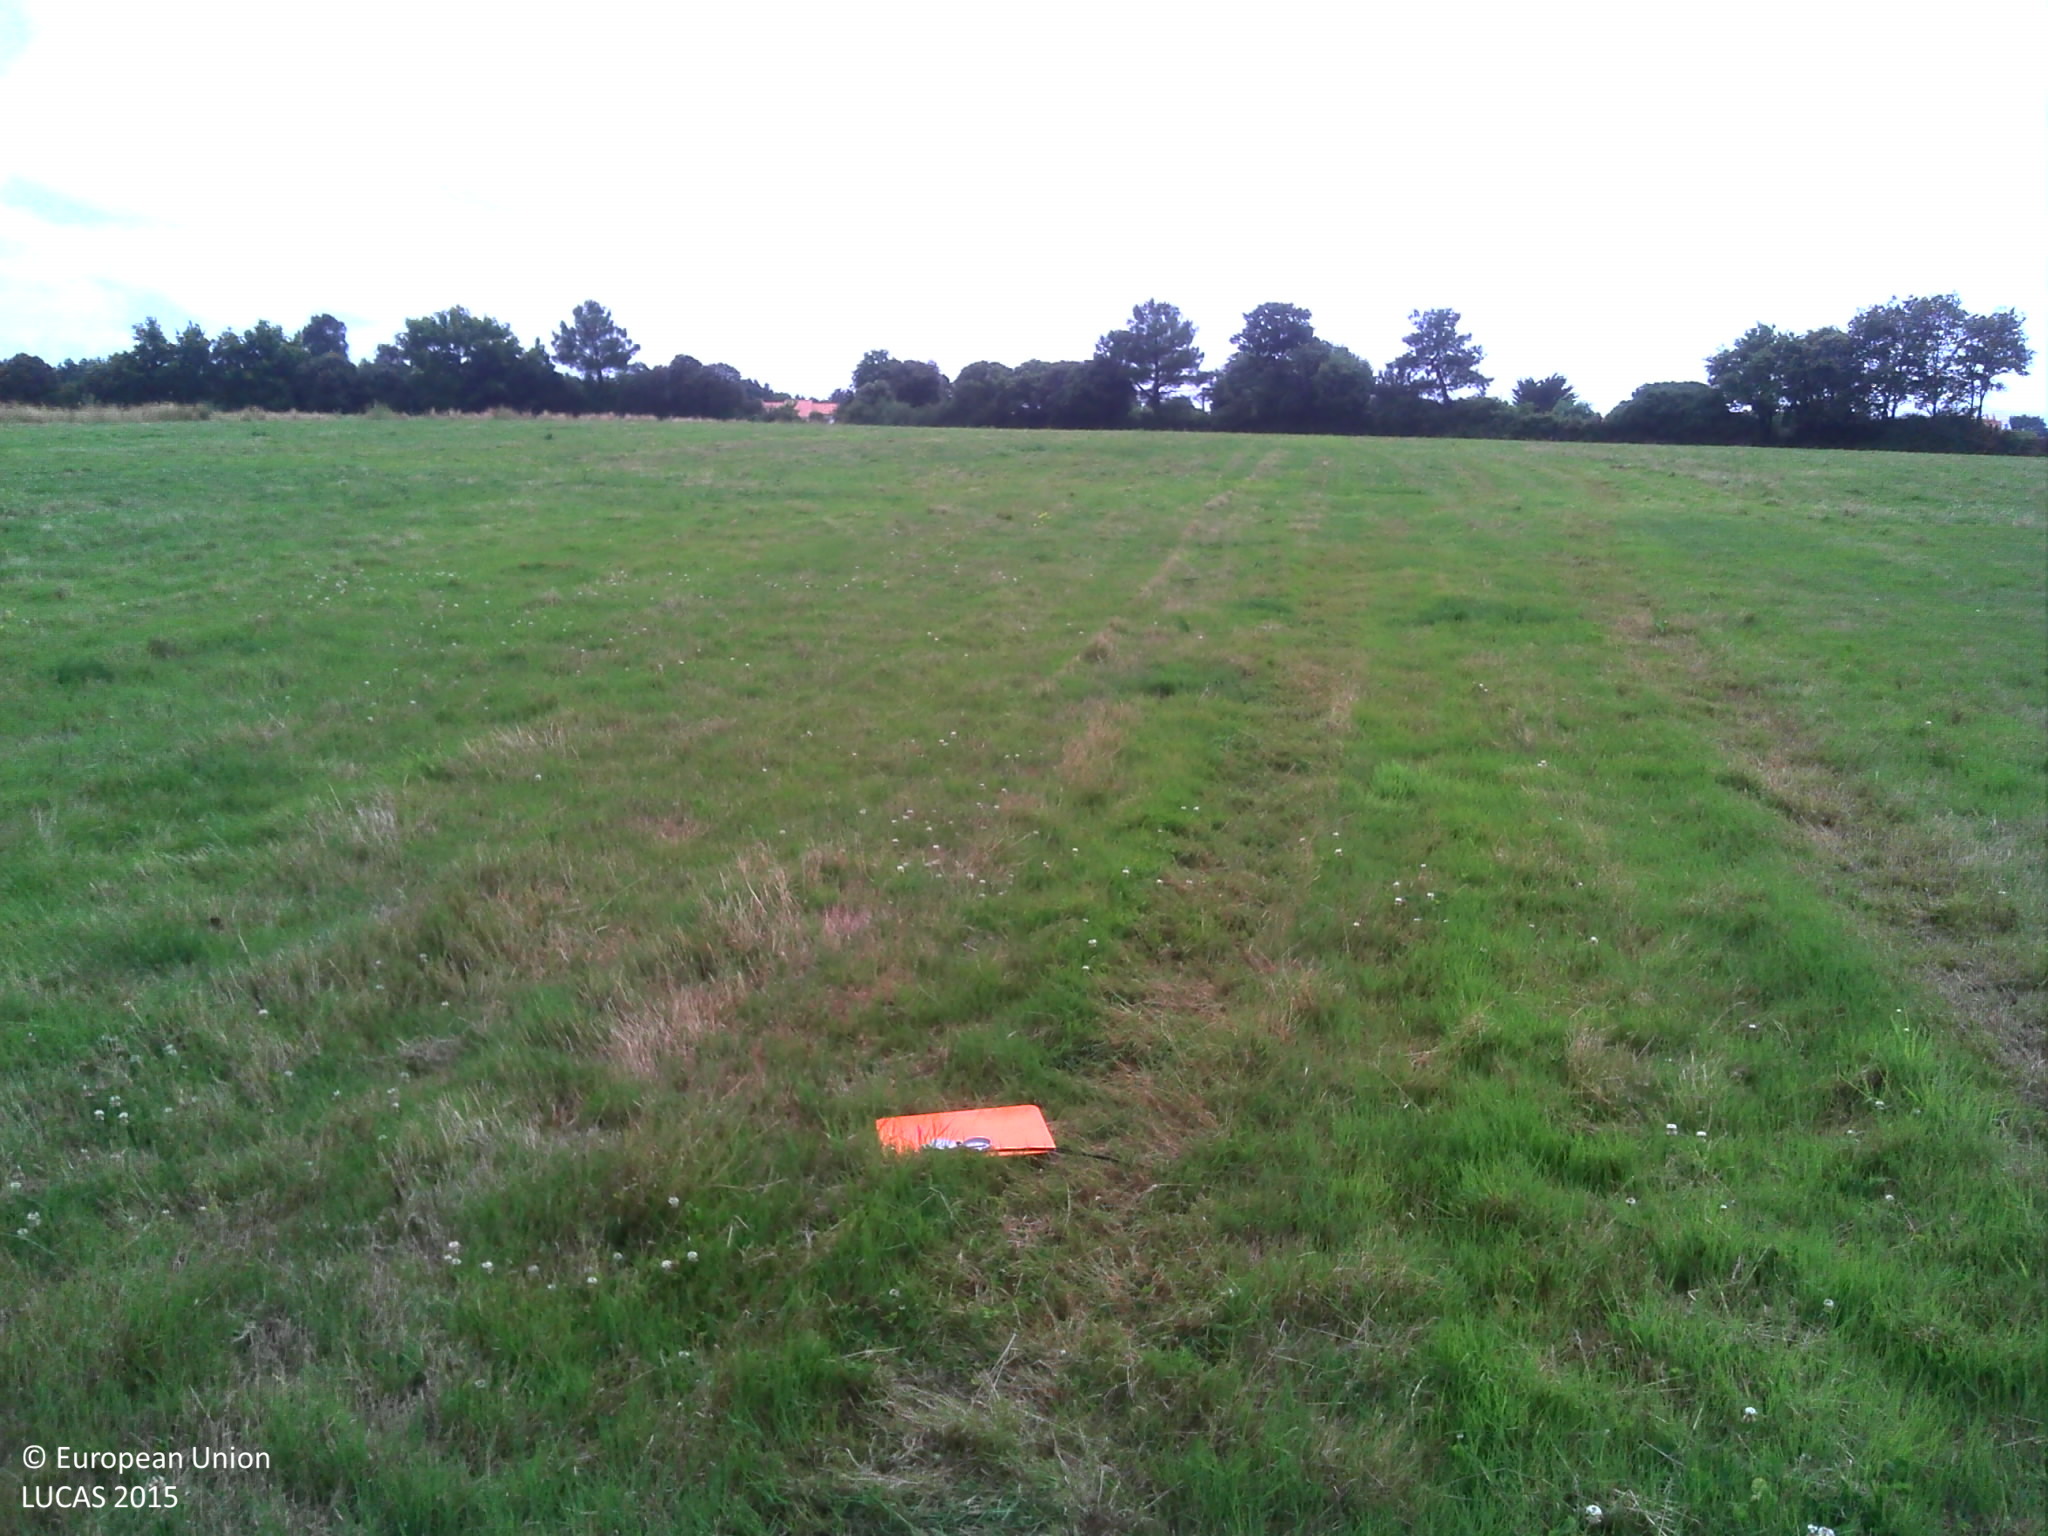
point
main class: Grassland
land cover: Grassland without tree/shrub cover
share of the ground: > 75 %
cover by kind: herbaceous plants 100 %
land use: Agriculture (excluding fallow land and kitchen gardens)
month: July
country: FR
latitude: 46.7140
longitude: -1.8032
